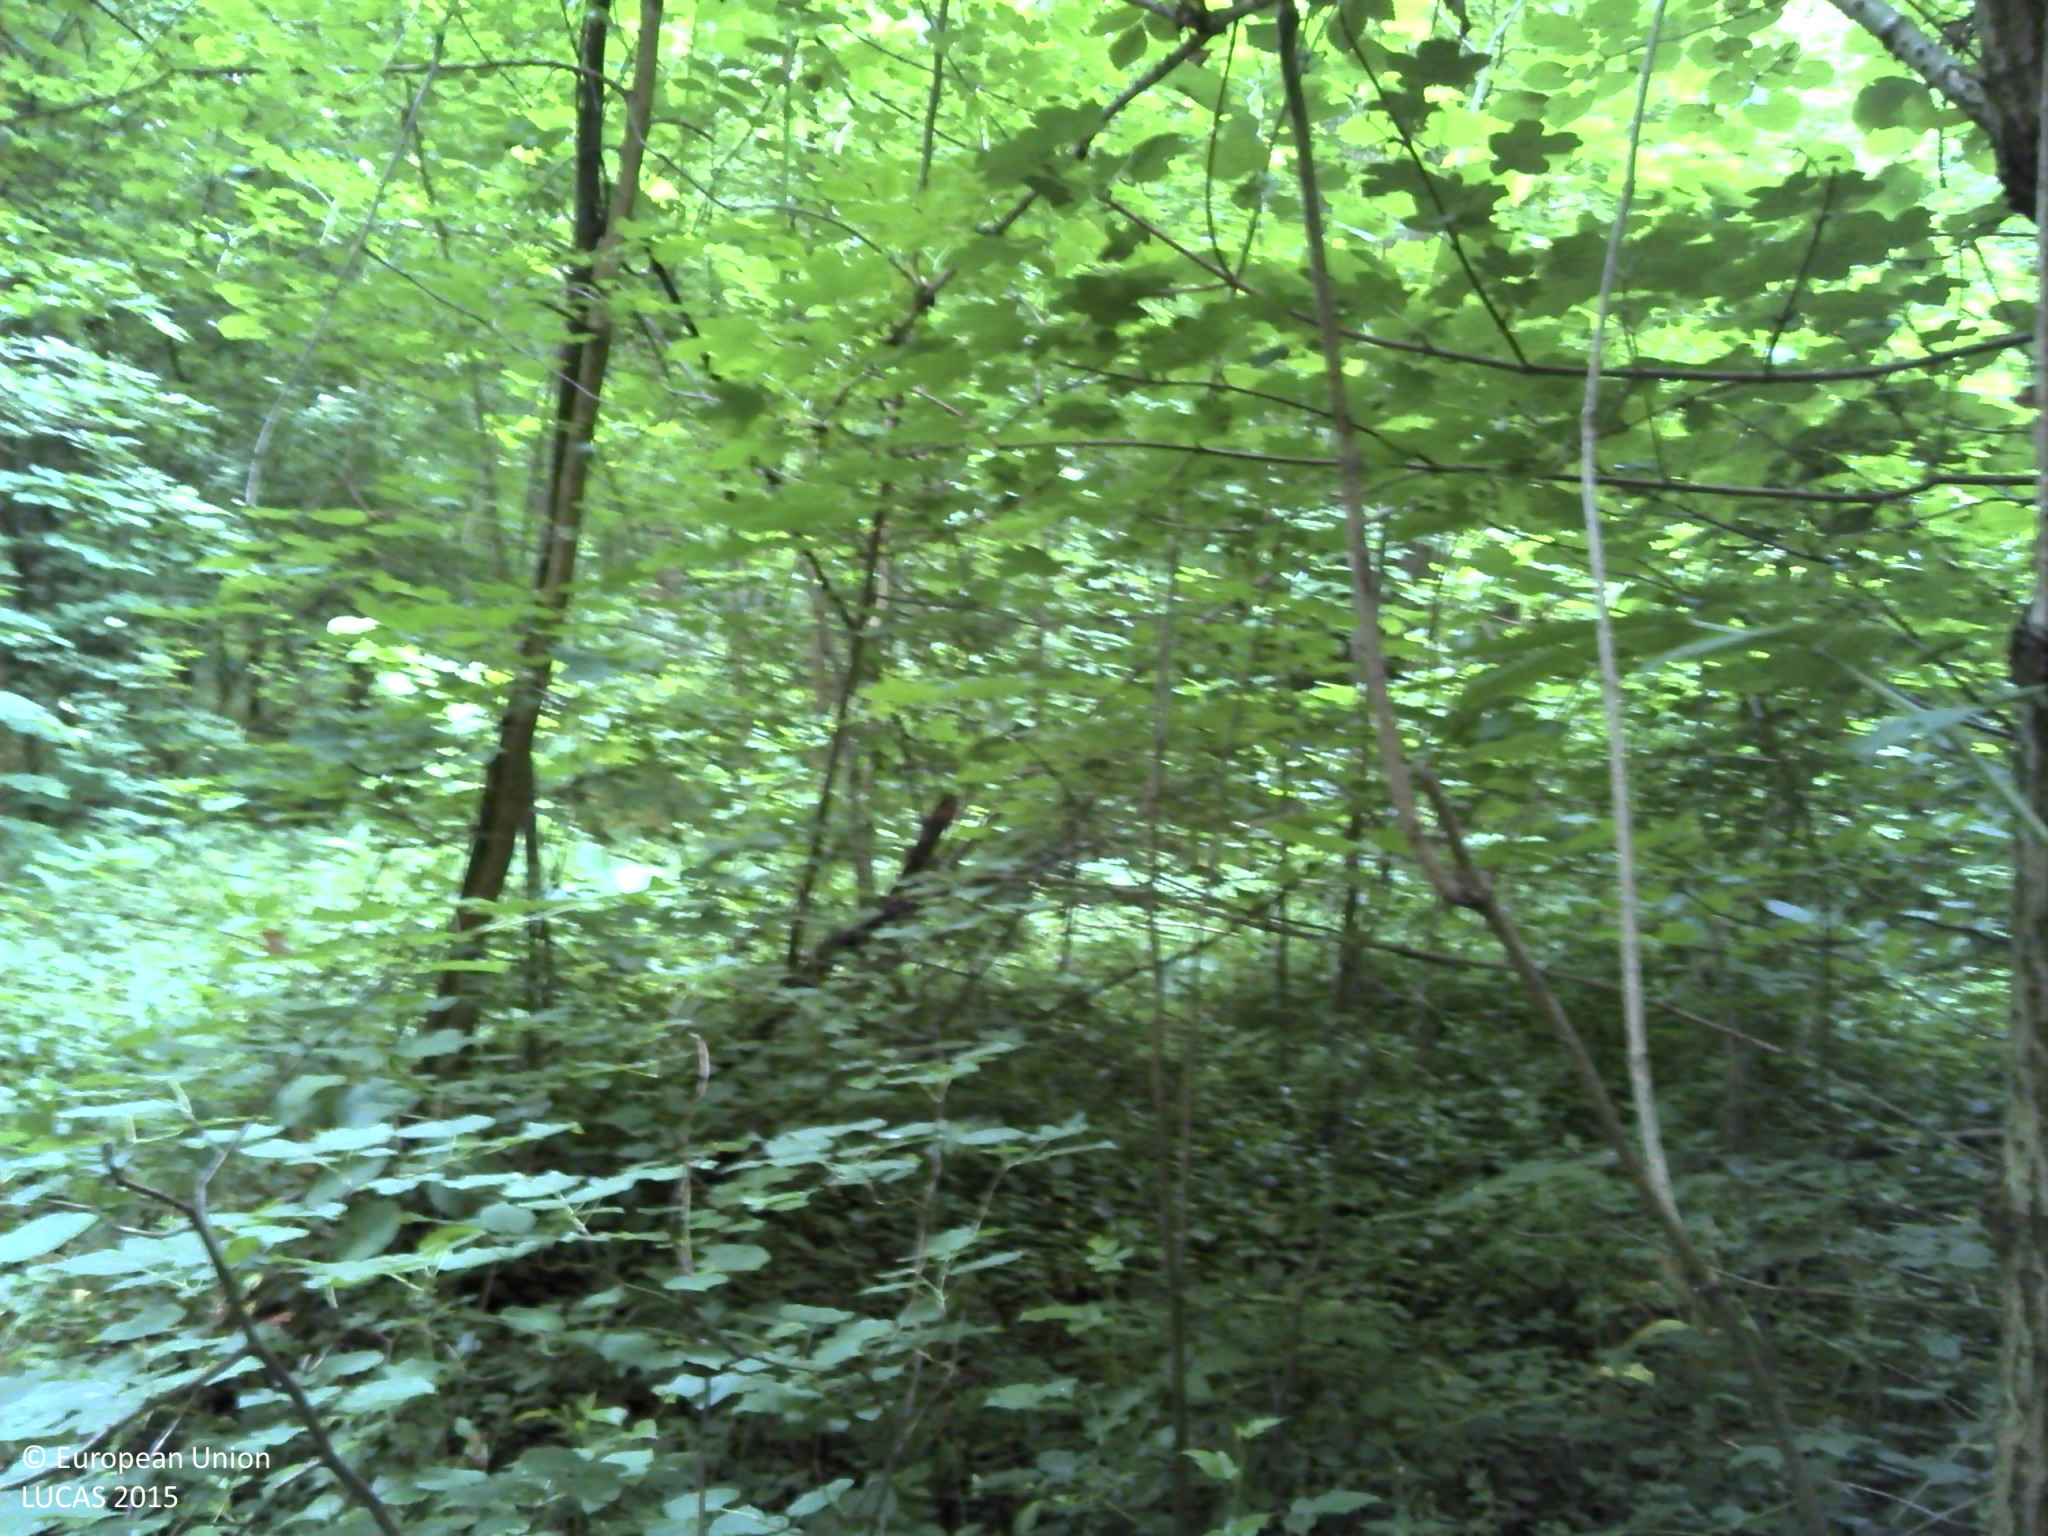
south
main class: Woodland
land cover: Broadleaved woodland
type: acidophilous oak and oak-birch forest
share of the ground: > 75 %
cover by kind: broadleaved forest trees 100 %
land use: Forestry
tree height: > 5 m
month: May
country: HR
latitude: 45.5619
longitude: 18.2431
